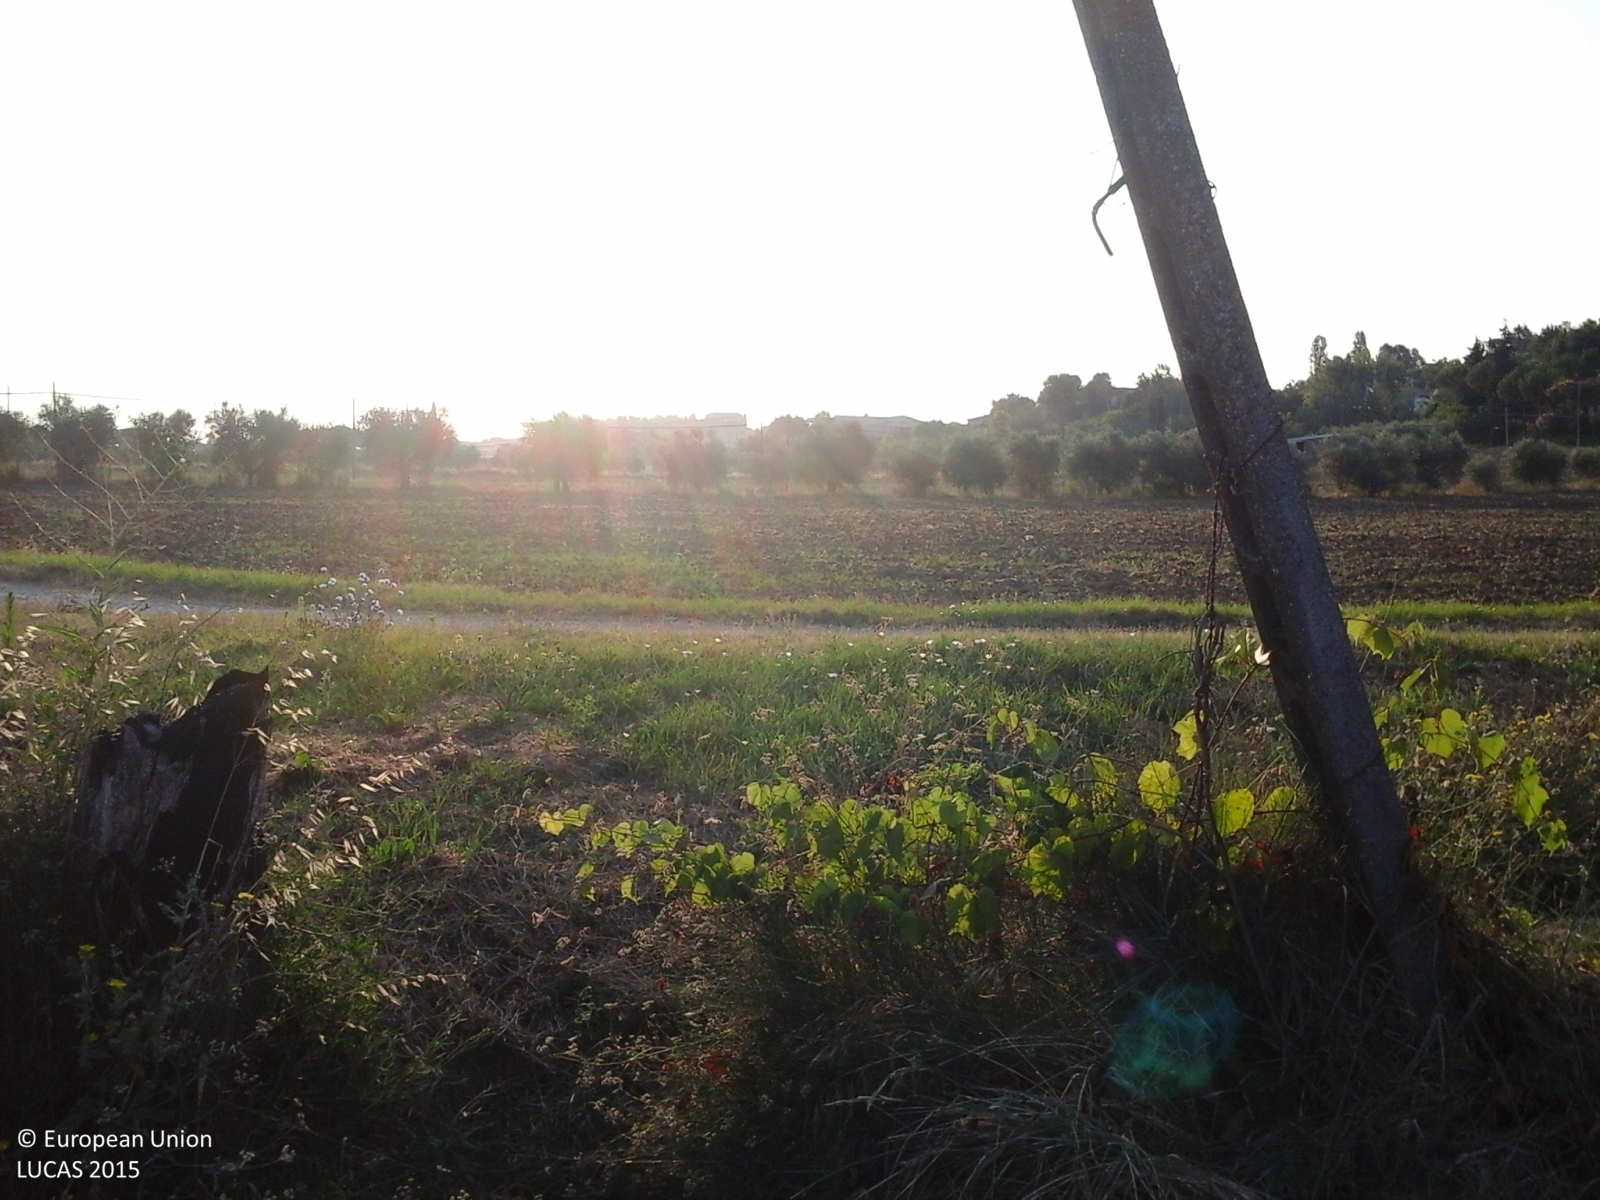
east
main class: Cropland
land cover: Other leguminous and mixtures for fodder
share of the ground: > 75 %
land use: Agriculture (excluding fallow land and kitchen gardens)
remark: Harvested field
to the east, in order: Other leguminous and mixtures for fodder; Grass margins; Ditches and canals; Grass margins; Tracks; Grass margins; Other bare soil; Olive groves; Other bare soil; Electric lines; Other bare soil; Electric lines; Other bare soil; Fences; Other bare soil; Olive groves; Other bare soil
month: July
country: IT
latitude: 44.0340
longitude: 12.4027
